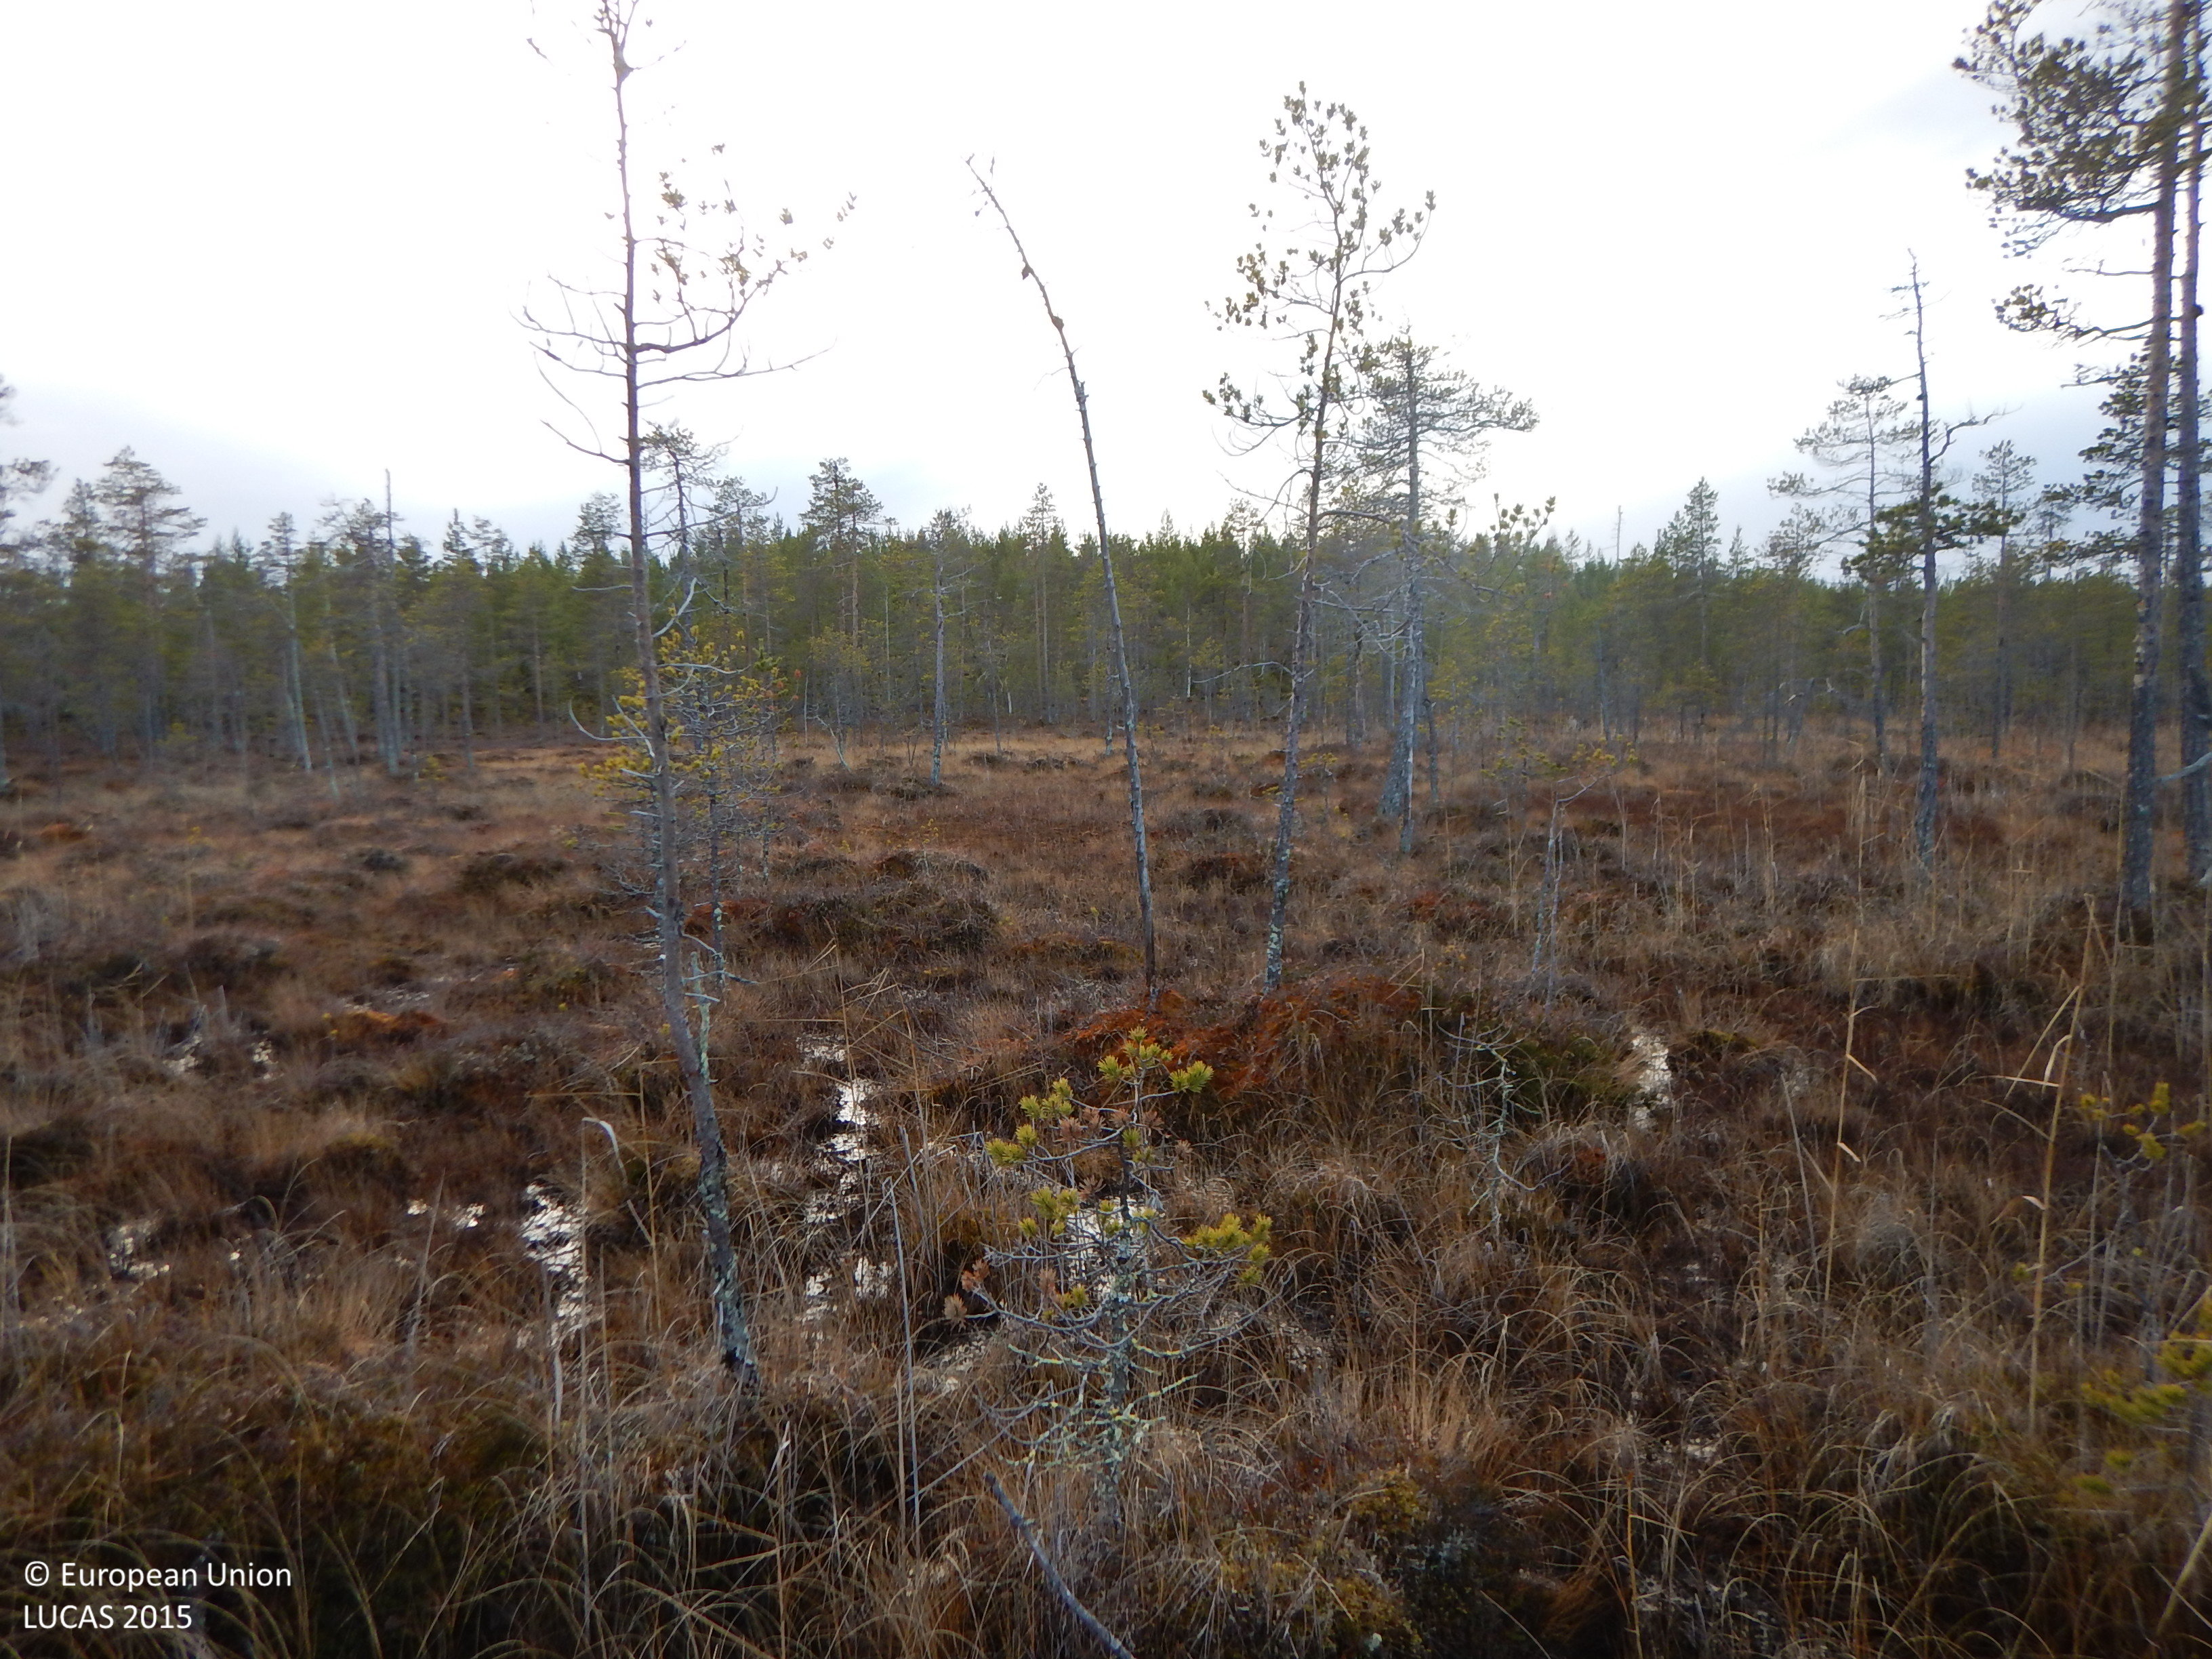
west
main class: Woodland
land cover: Pine dominated coniferous woodland
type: mire and swamp forests
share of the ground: 25 - 50 %
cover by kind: coniferous forest trees 30 %, lichens and mosses 30 %, herbaceous plants 20 %, shrubs 15 %, broadleaved forest trees 5 %
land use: Semi-natural and natural areas not in use
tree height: < 5 m
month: October
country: SE
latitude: 65.3201
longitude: 20.0329
